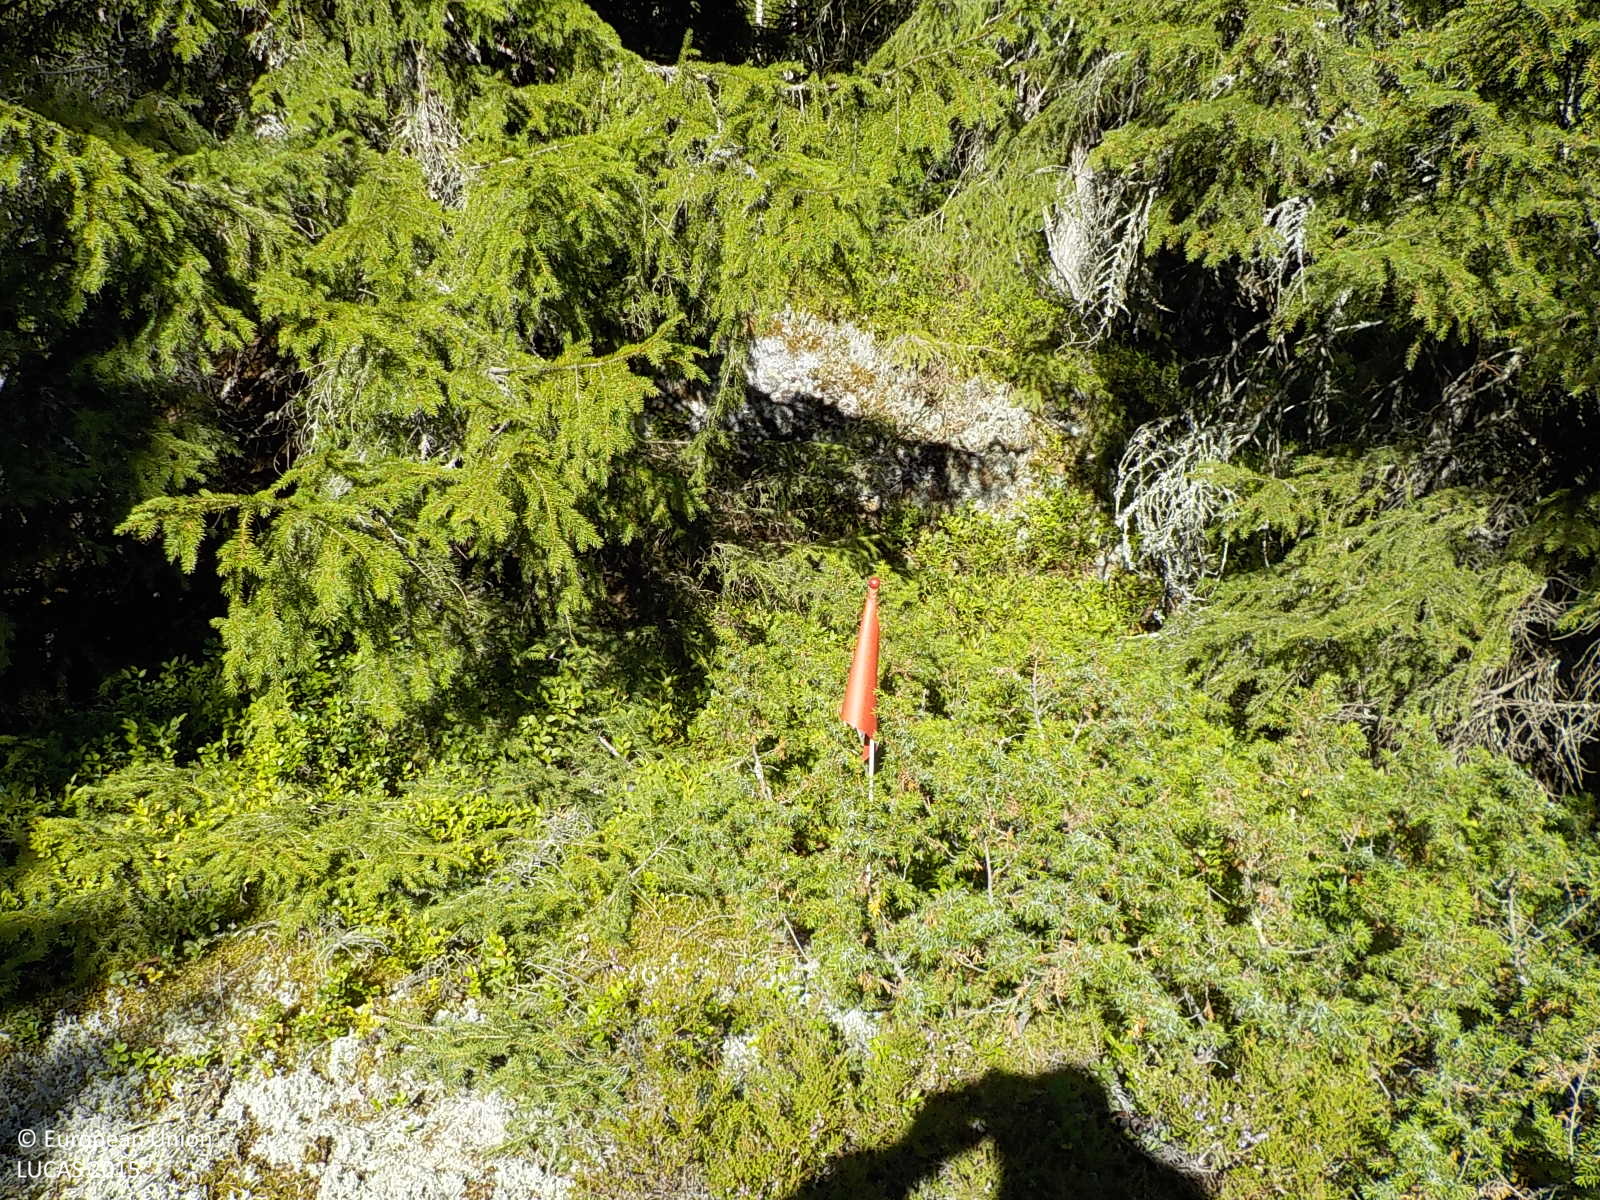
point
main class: Woodland
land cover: Spruce dominated mixed woodland
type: boreal forest
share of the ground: > 75 %
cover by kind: coniferous forest trees 60 %, broadleaved forest trees 20 %, herbaceous plants 20 %
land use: Forestry
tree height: > 5 m
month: August
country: SE
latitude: 63.3408
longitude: 18.7077
